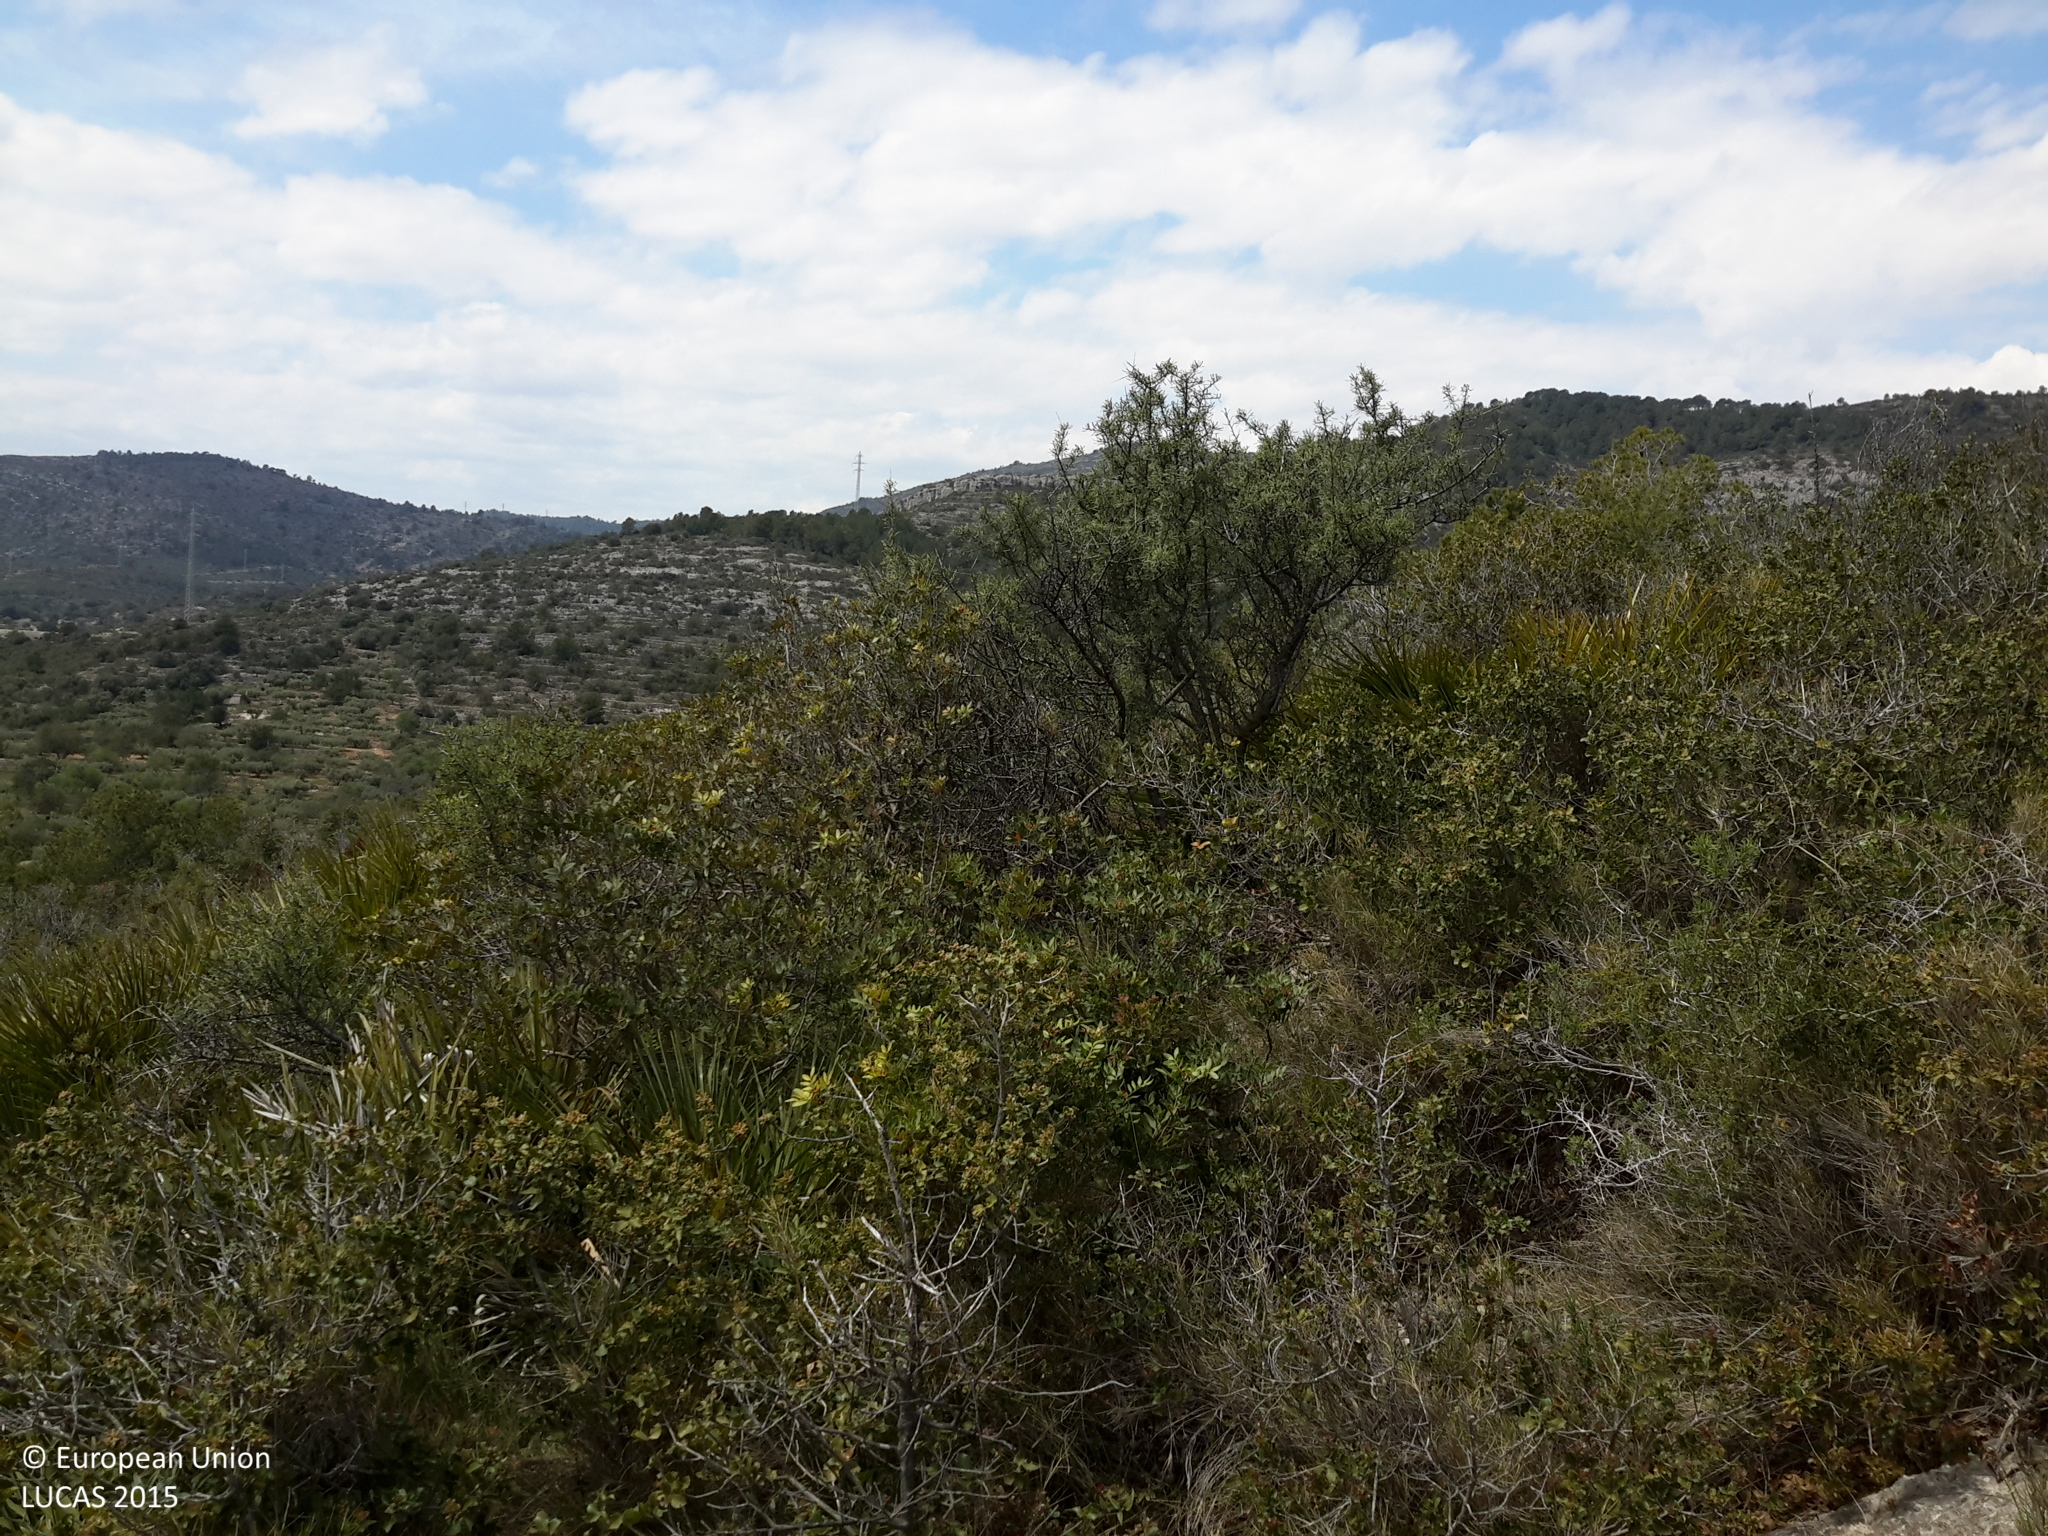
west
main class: Shrubland
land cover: Shrubland with sparse tree cover
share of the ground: > 75 %
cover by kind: shrubs 70 %, unconsolidated bare surface 25 %, coniferous forest trees 5 %
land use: Semi-natural and natural areas not in use
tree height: < 5 m
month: April
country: ES
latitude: 40.5709
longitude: 0.5107
